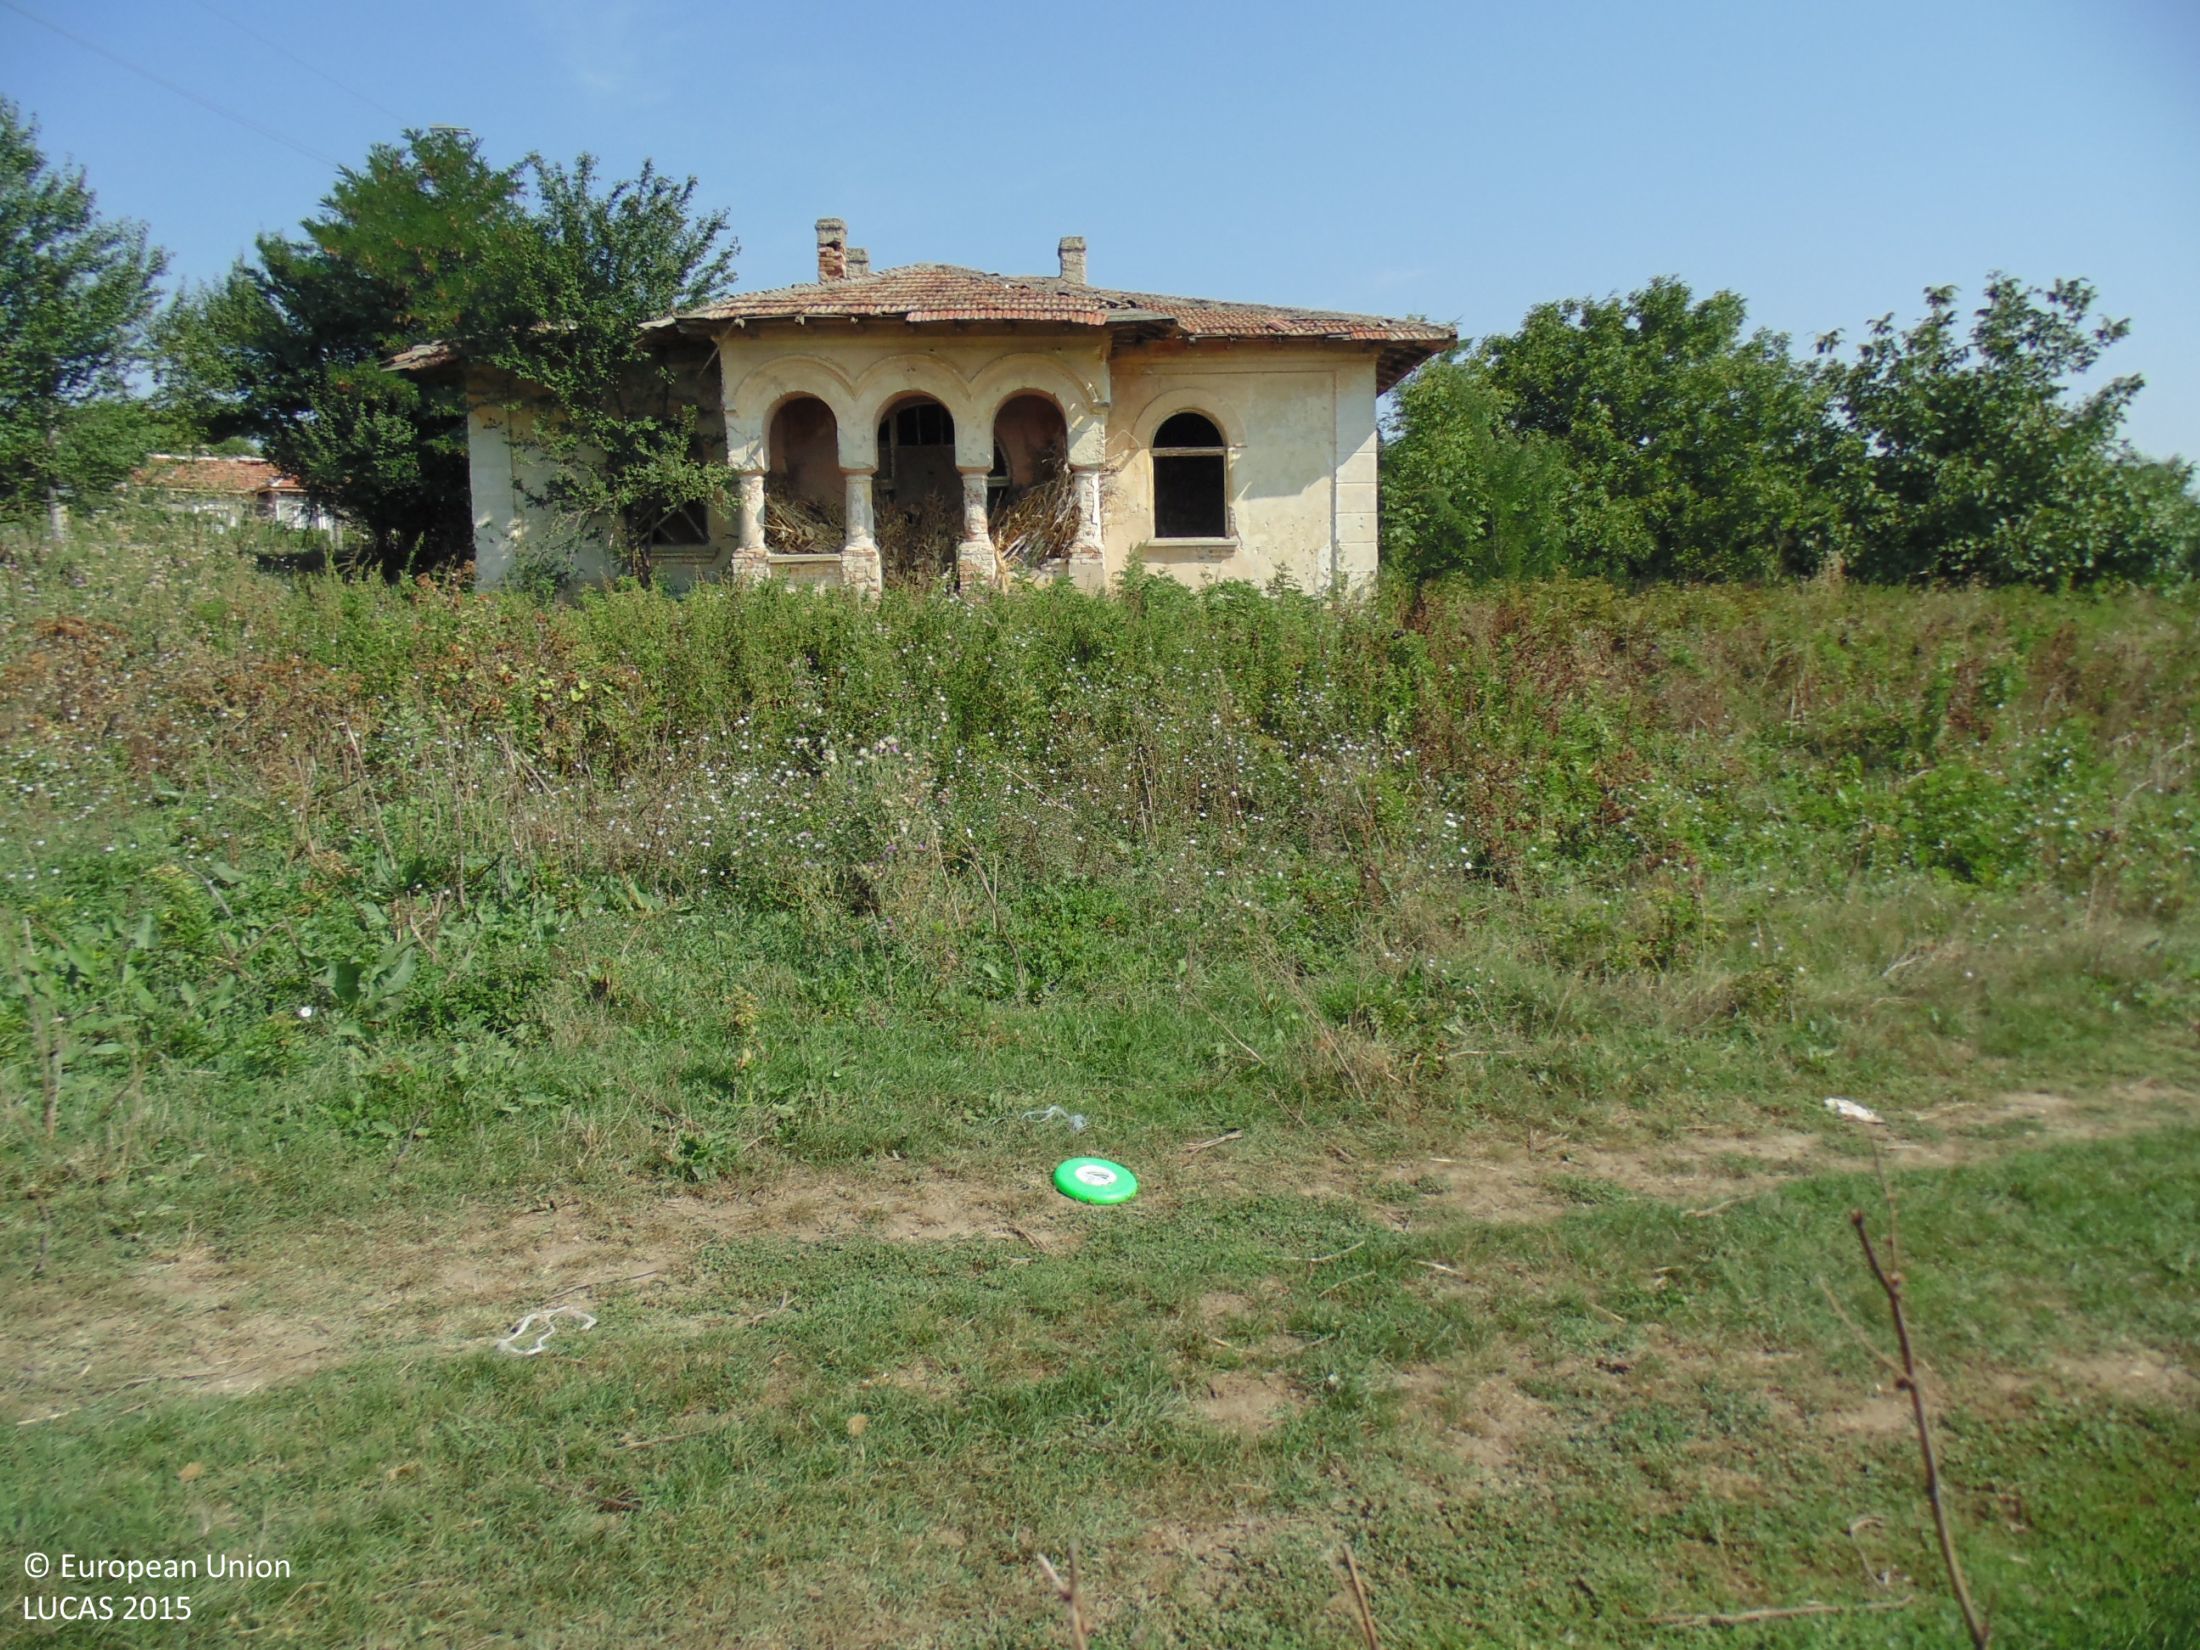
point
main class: Grassland
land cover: Spontaneously vegetated surfaces
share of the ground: > 75 %
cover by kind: herbaceous plants 100 %
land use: Residential
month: September
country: BG
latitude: 43.7415
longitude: 27.0205
